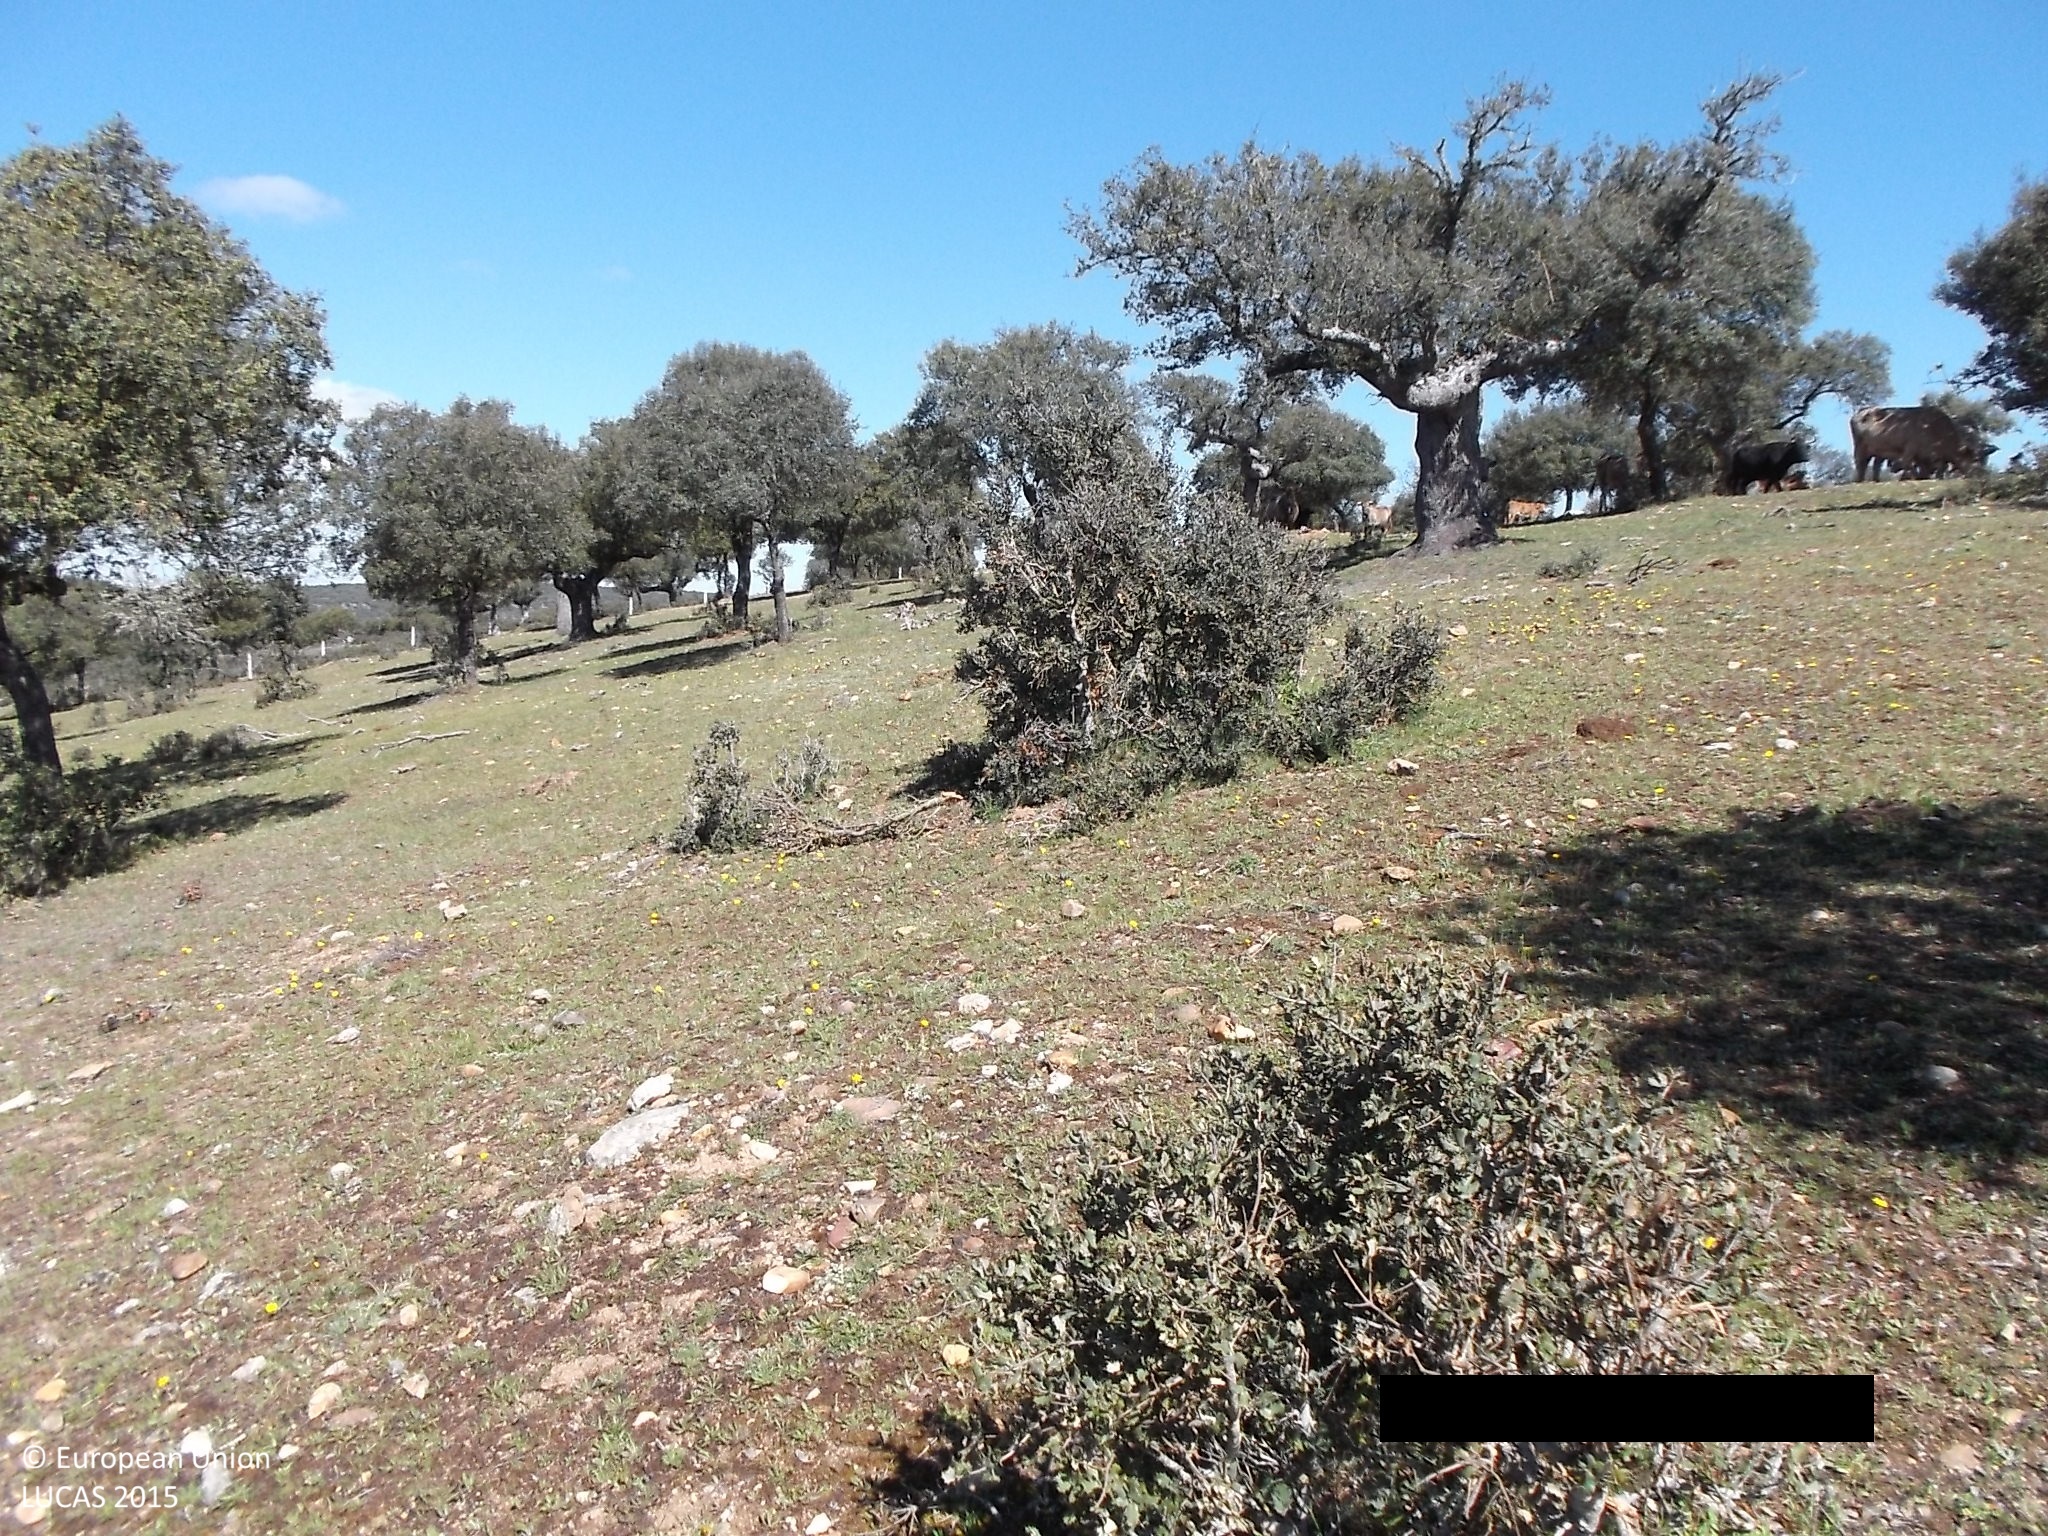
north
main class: Woodland
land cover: Broadleaved woodland
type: broadleaved evergreen forest
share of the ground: 25 - 50 %
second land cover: Grassland without tree/shrub cover
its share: 50 - 75 %
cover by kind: herbaceous plants 50 %, broadleaved forest trees 30 %, shrubs 20 %
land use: Forestry
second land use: Agriculture (excluding fallow land and kitchen gardens)
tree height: < 5 m
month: April
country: ES
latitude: 41.0722
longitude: -5.9249
